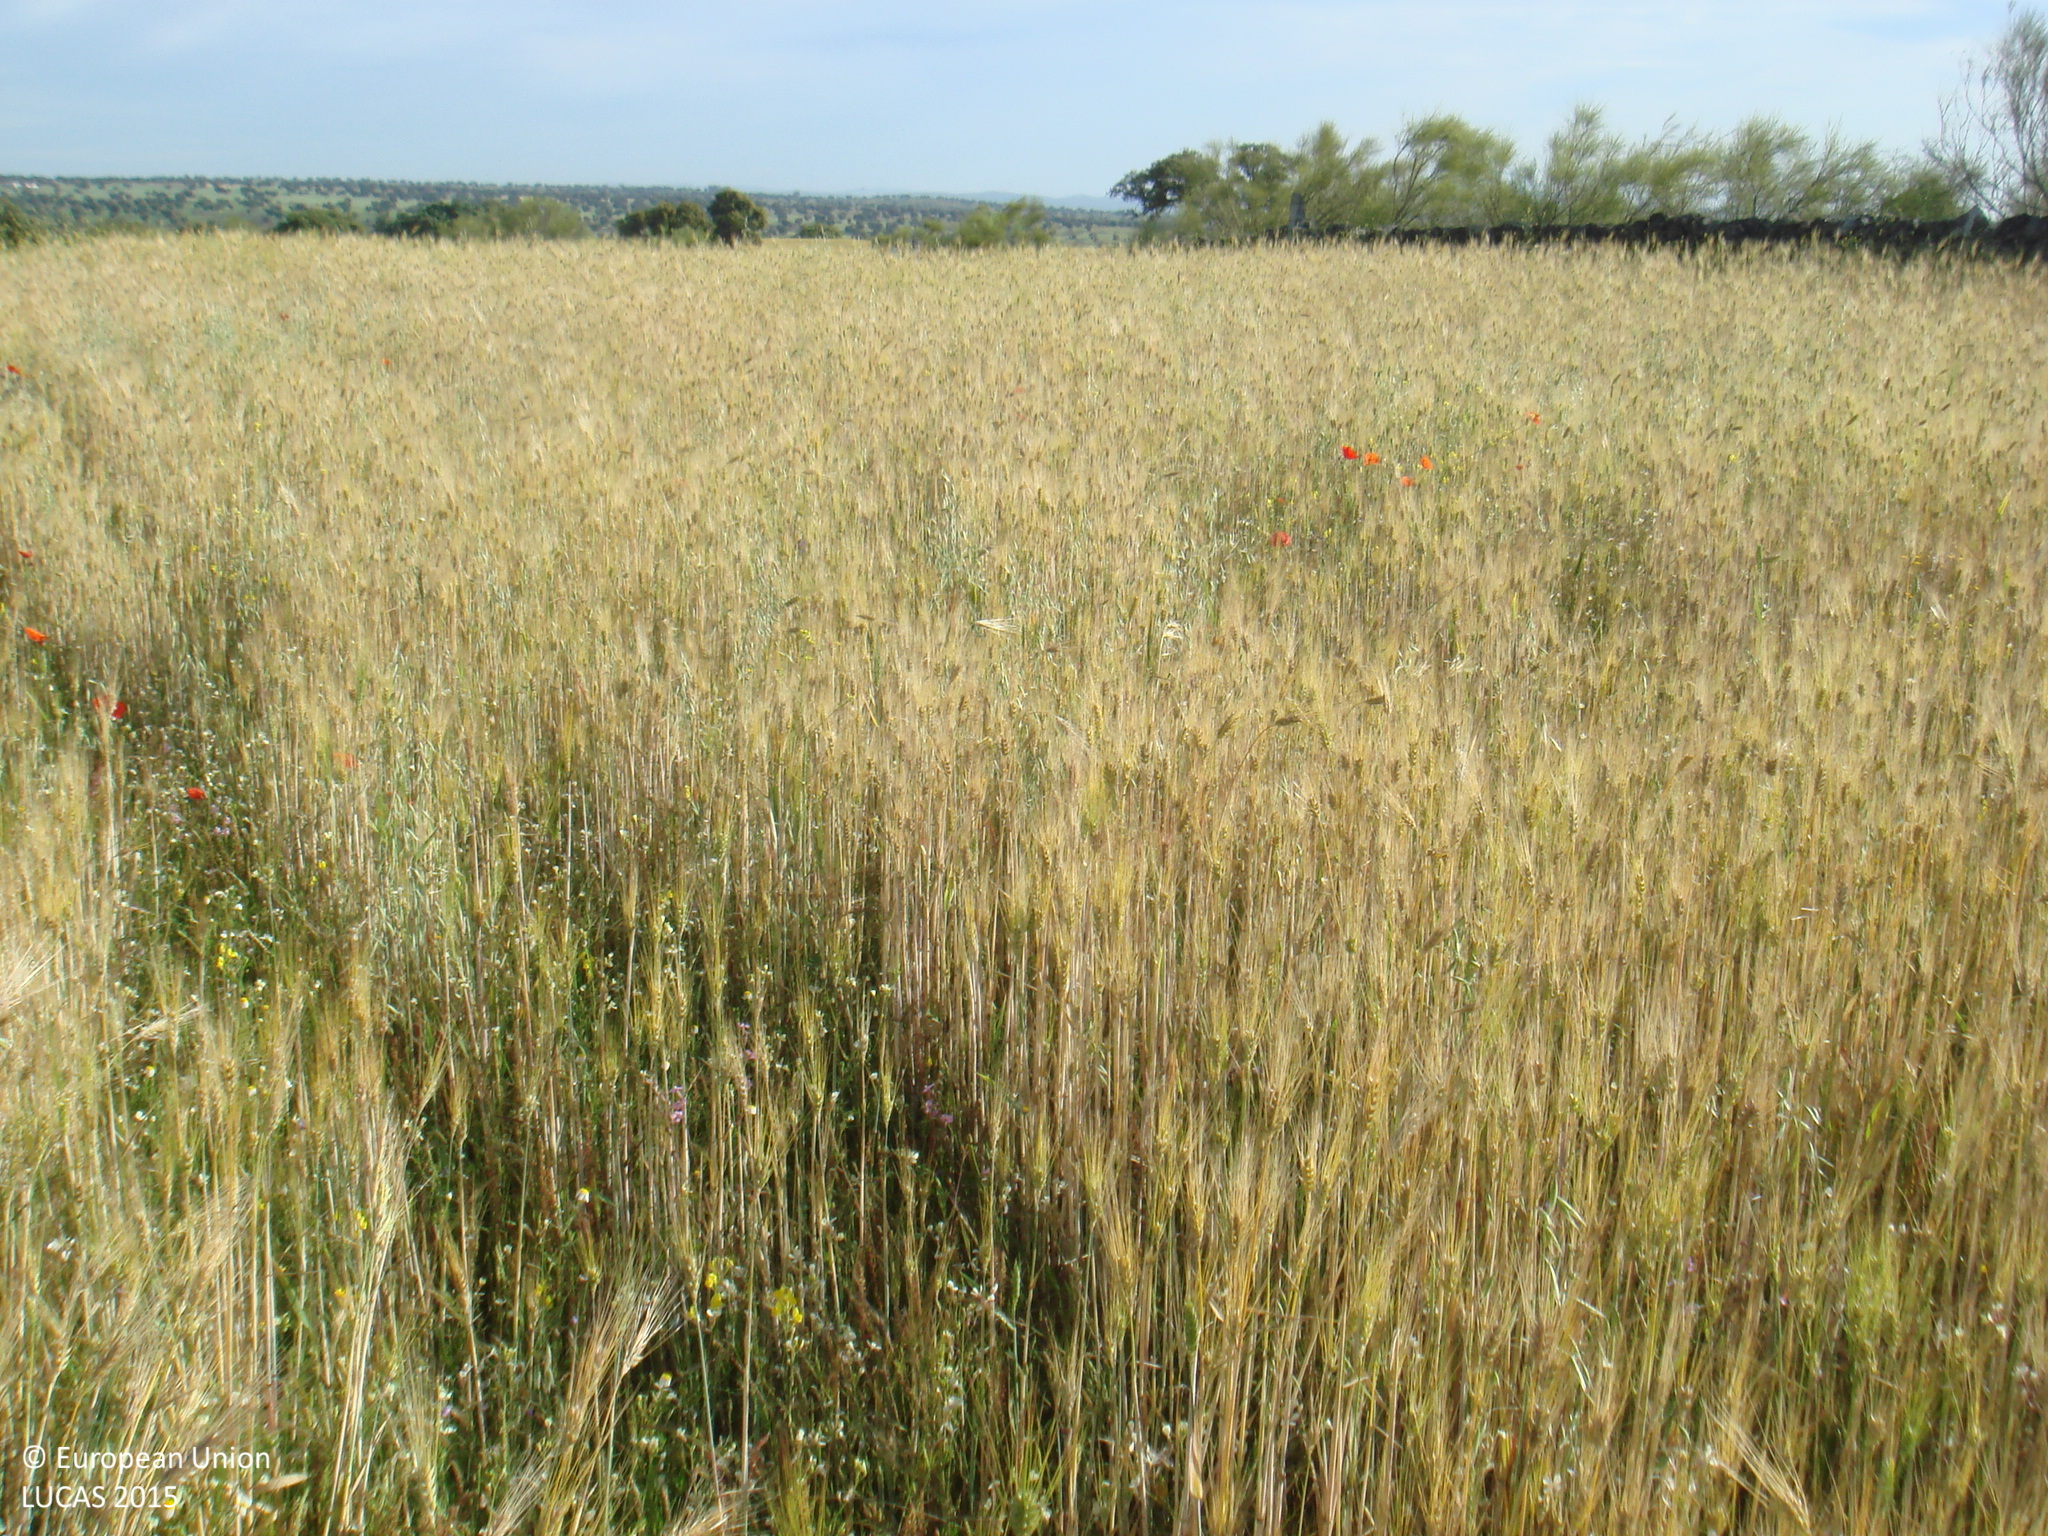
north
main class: Cropland
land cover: Durum wheat
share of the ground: > 75 %
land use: Agriculture (excluding fallow land and kitchen gardens)
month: May
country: ES
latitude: 38.4379
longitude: -5.0468
